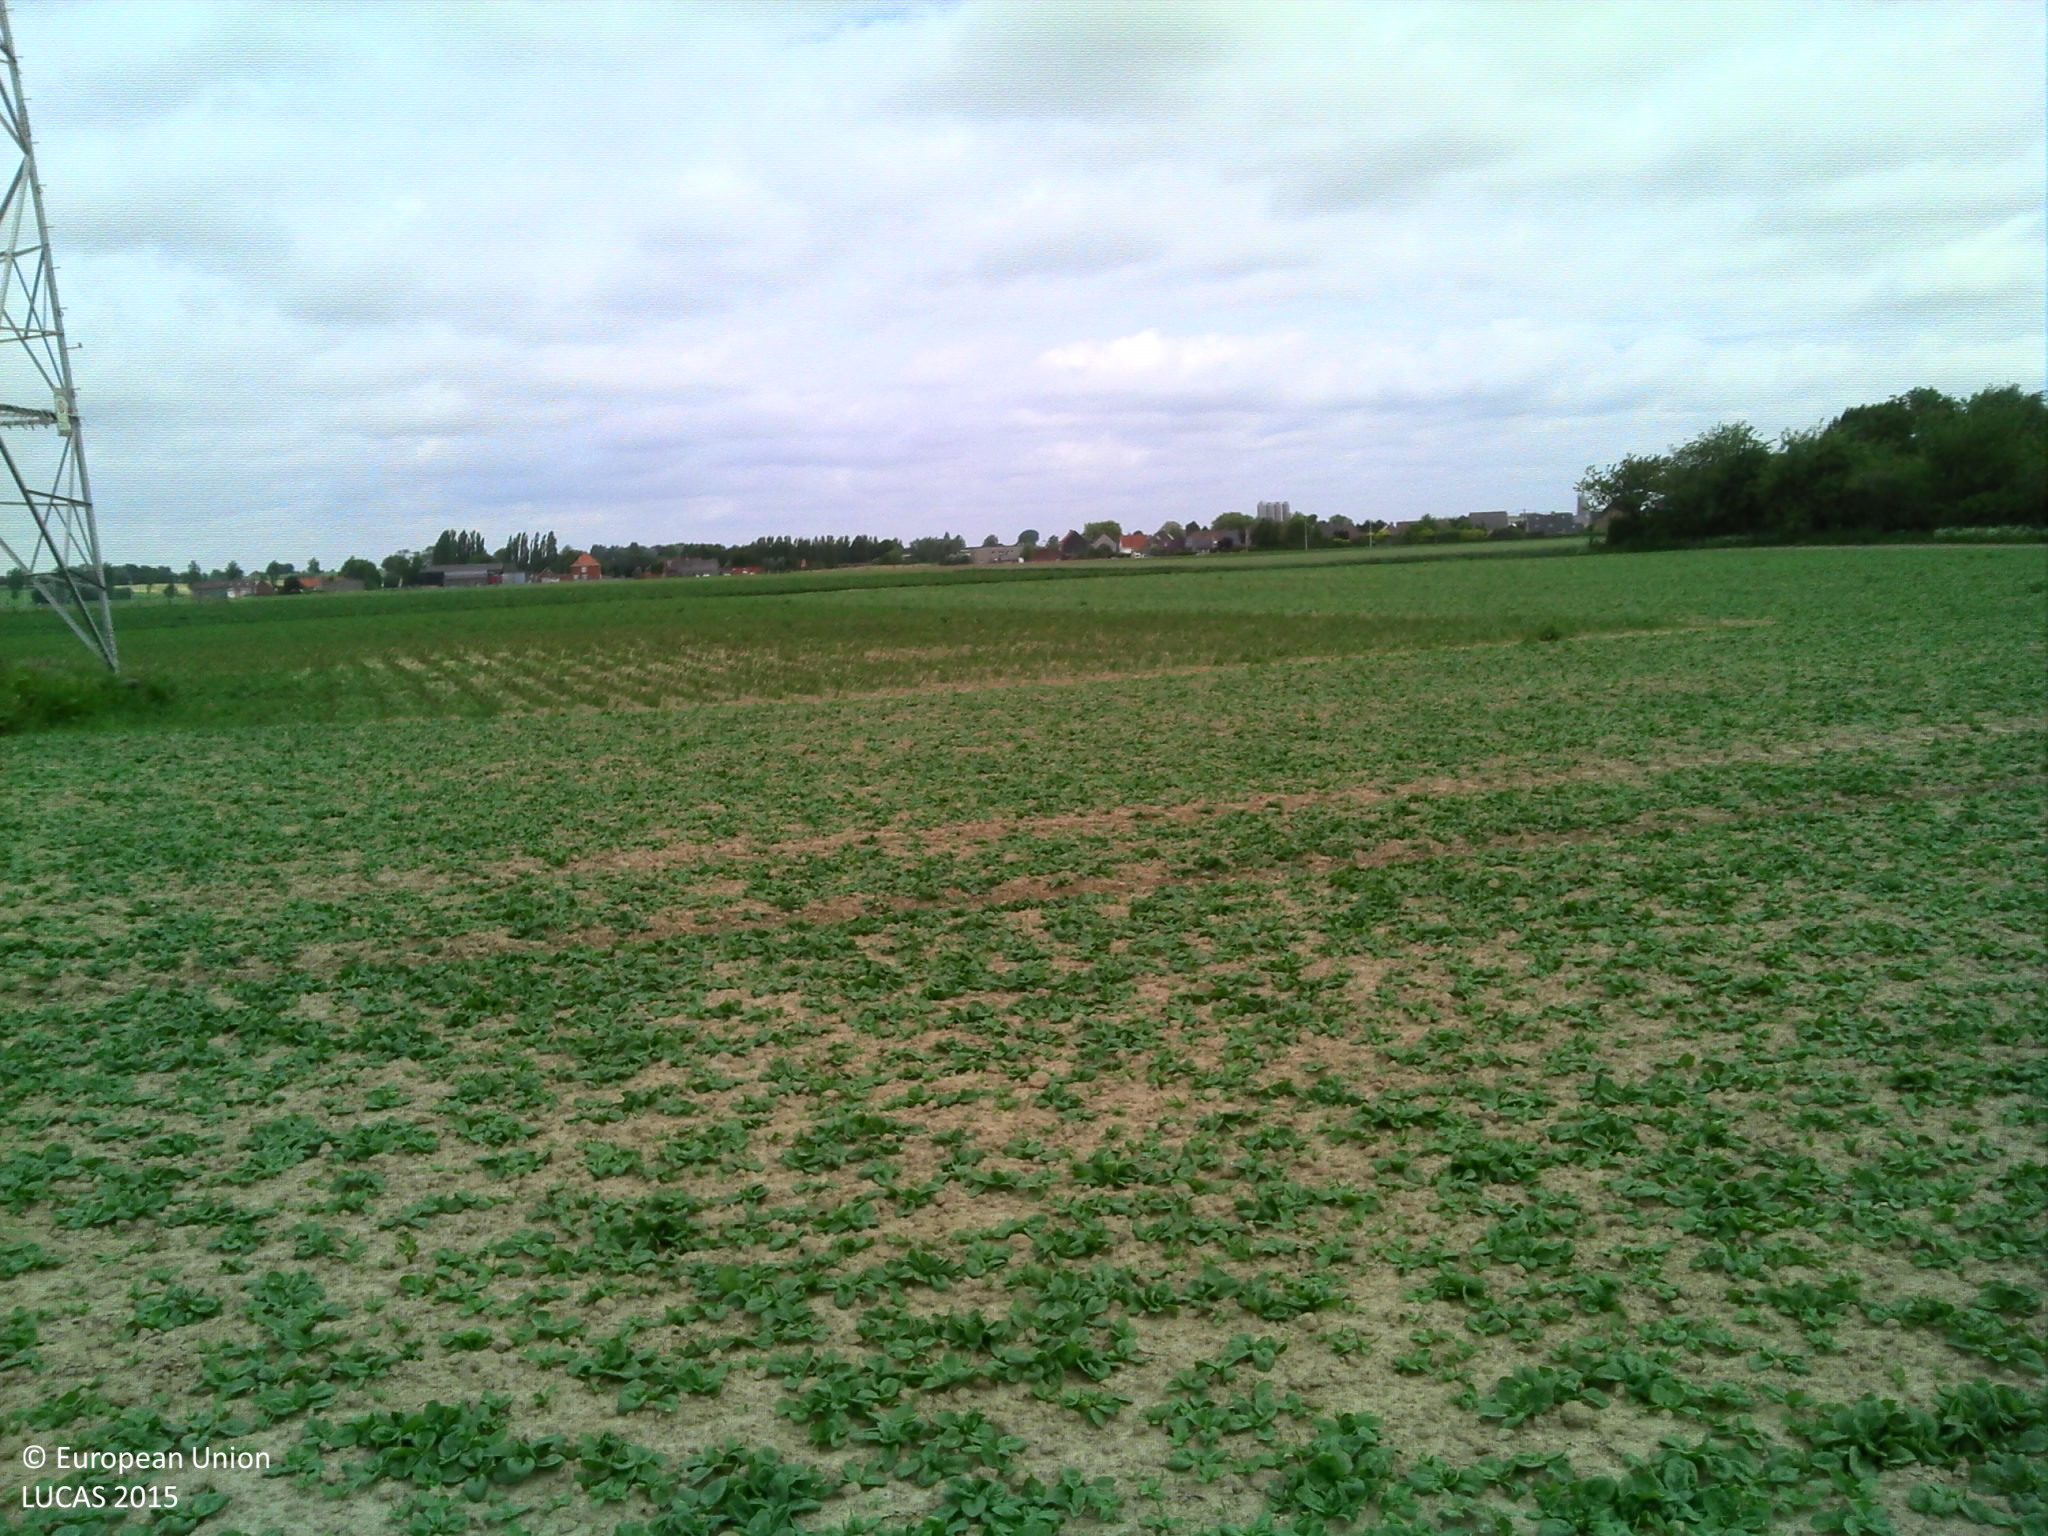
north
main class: Cropland
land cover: Other fresh vegetables
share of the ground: 50 - 75 %
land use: Agriculture (excluding fallow land and kitchen gardens)
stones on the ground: < 10 %
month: June
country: BE
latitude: 50.9685
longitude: 3.1125
